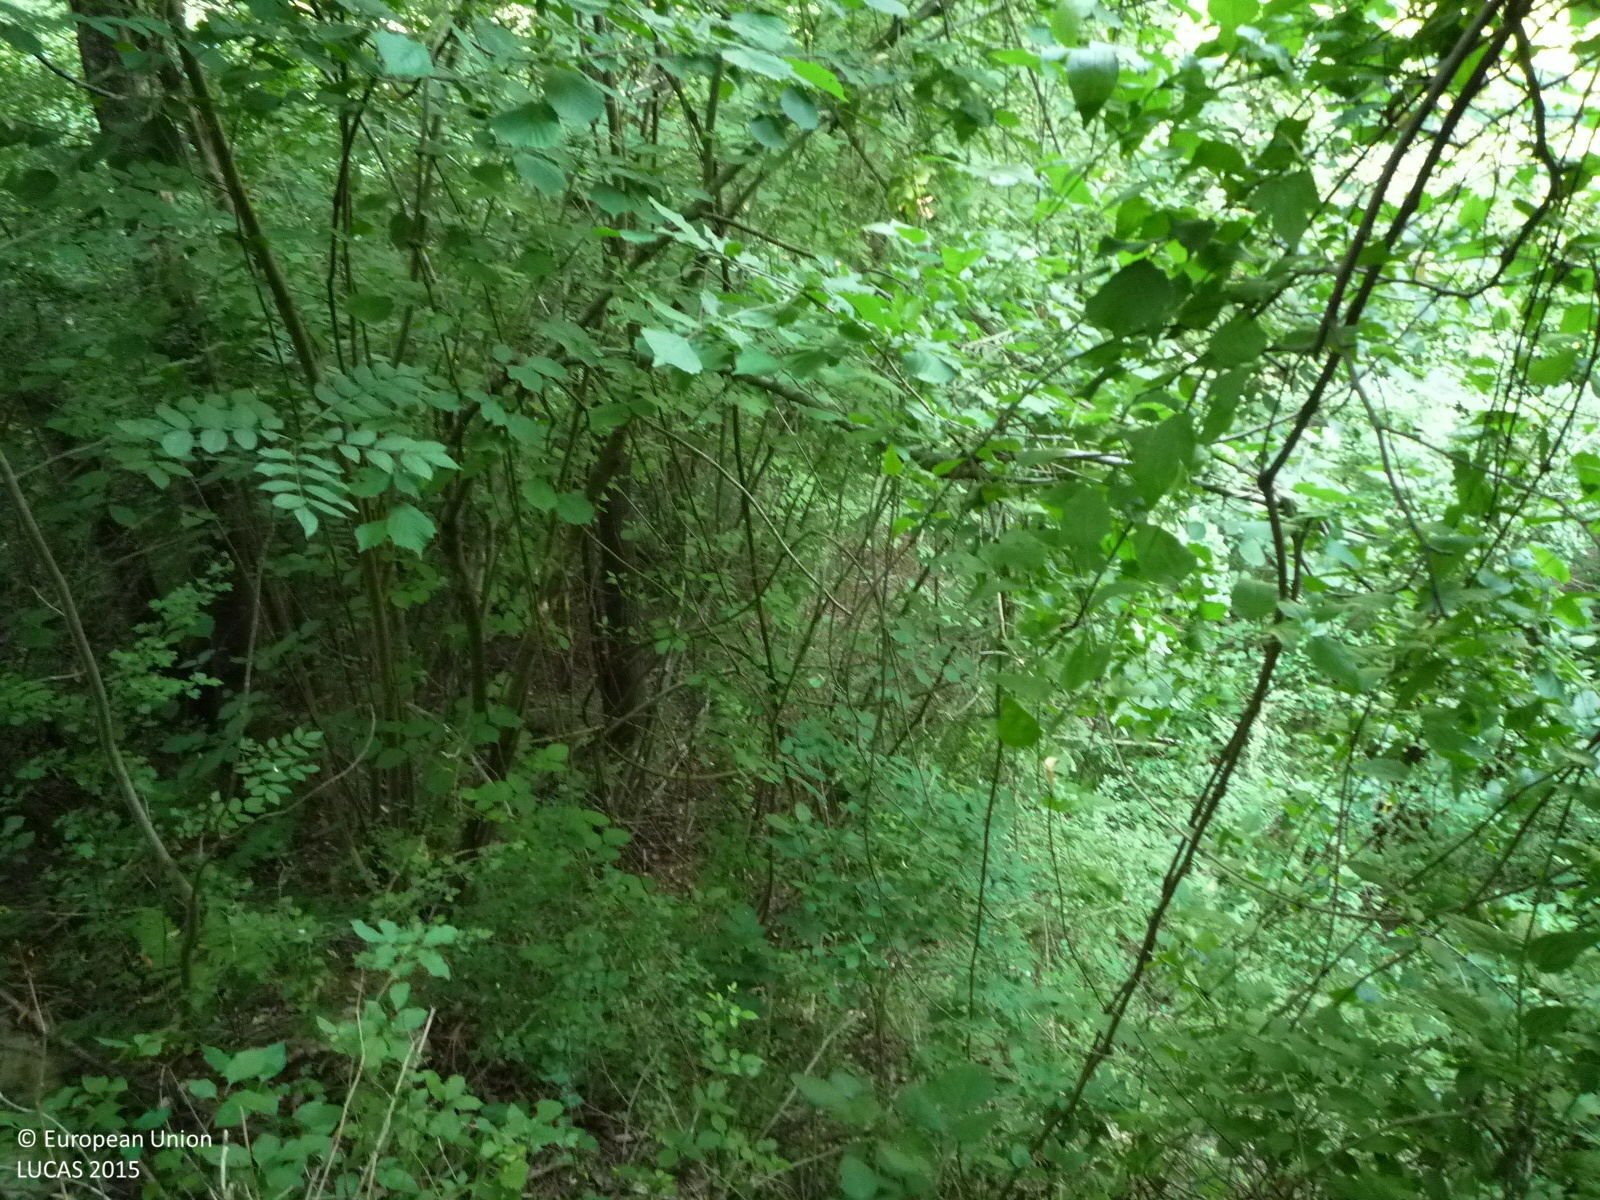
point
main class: Woodland
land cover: Other mixed woodland
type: thermophilous deciduous forest
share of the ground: > 75 %
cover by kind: broadleaved forest trees 75 %, coniferous forest trees 25 %
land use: Forestry
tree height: > 5 m
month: July
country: ES
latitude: 42.1312
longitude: 1.9196
